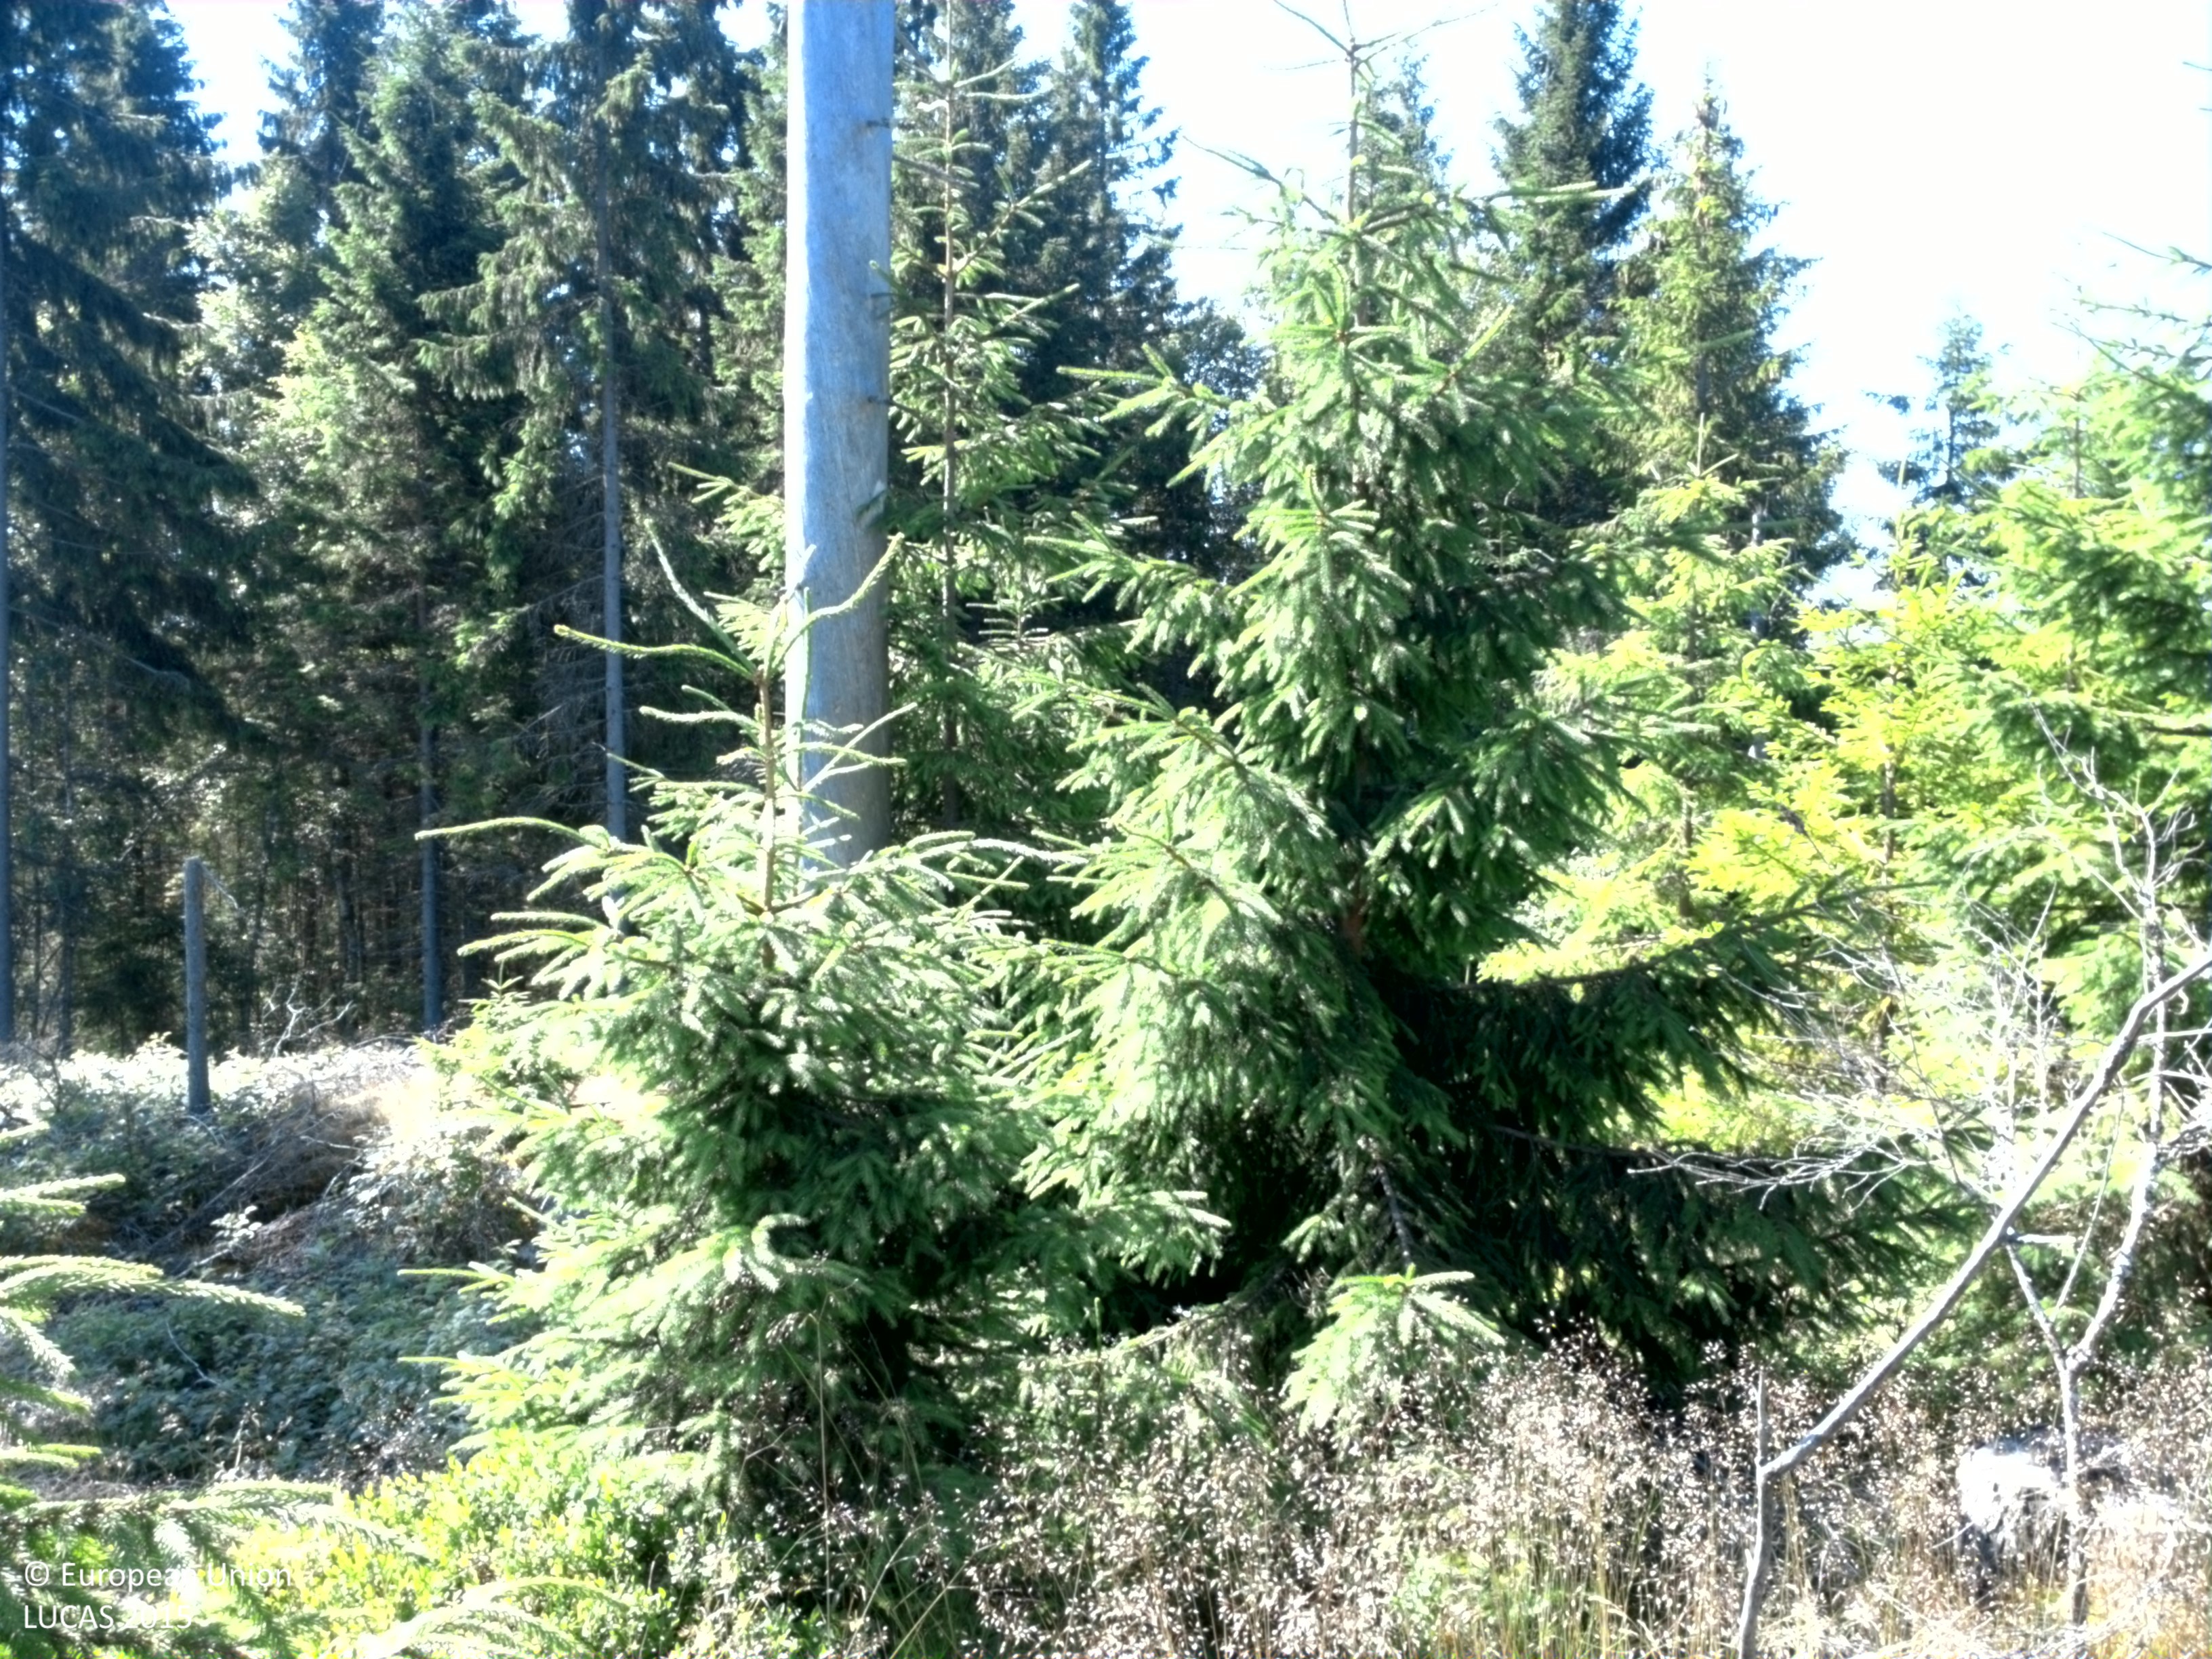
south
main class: Woodland
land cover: Spruce dominated coniferous woodland
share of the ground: 10 - 25 %
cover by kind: shrubs 45 %, herbaceous plants 40 %, coniferous forest trees 15 %
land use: Forestry
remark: Clear cut
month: July
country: SE
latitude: 59.7149
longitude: 14.4170
